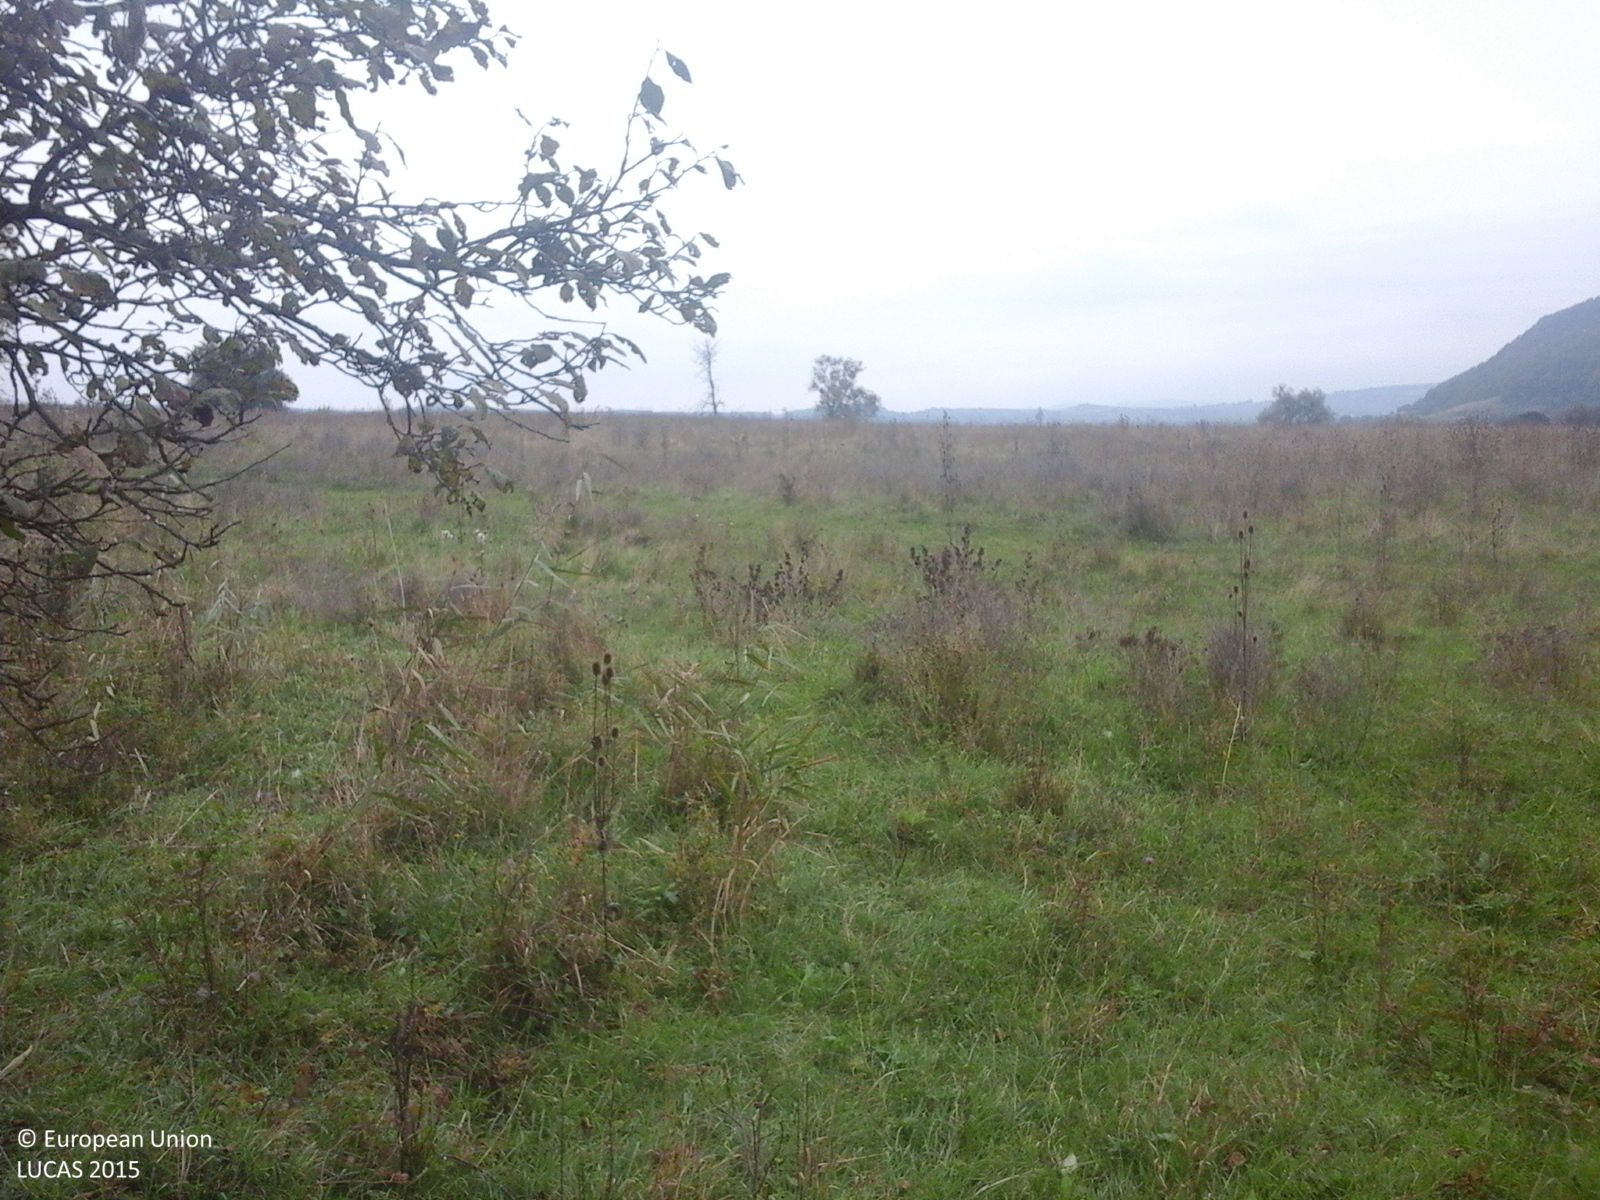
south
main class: Woodland
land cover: Broadleaved woodland
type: beech forest
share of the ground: > 75 %
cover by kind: broadleaved forest trees 100 %
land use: Forestry
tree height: > 5 m
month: October
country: RO
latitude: 46.1473
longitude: 24.8642
